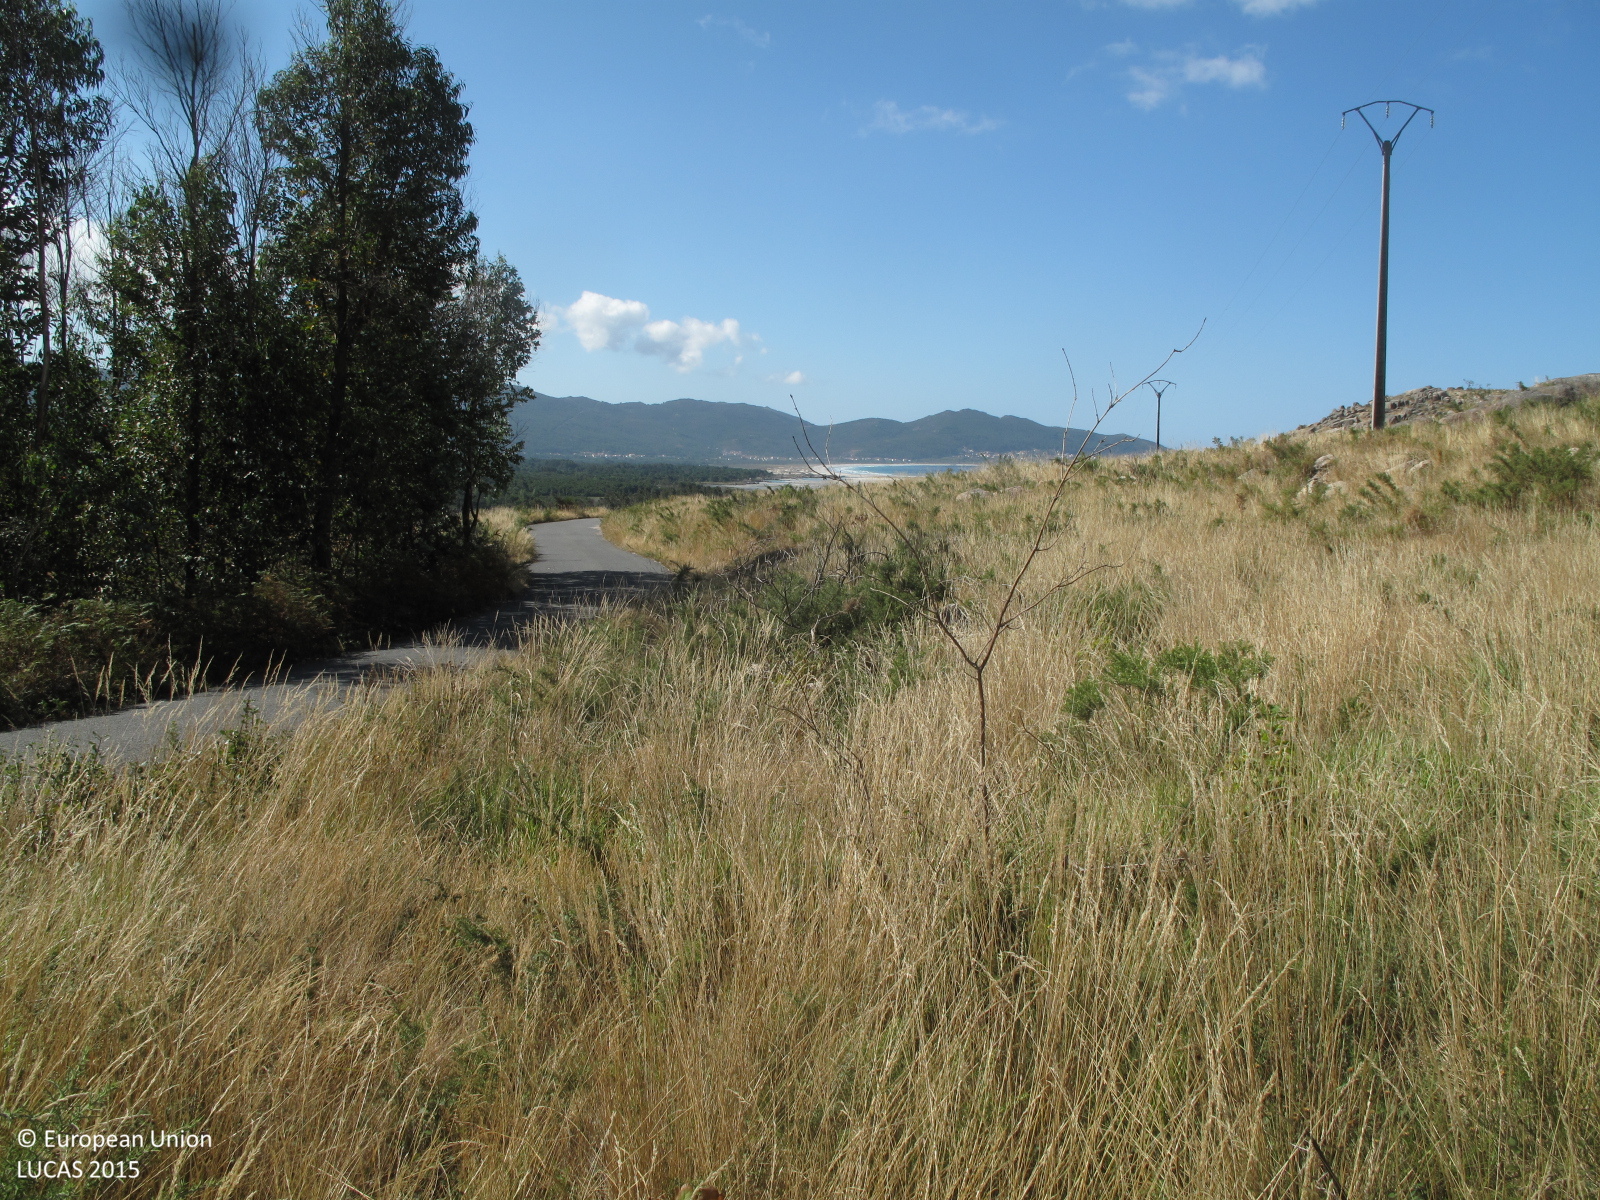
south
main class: Shrubland
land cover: Shrubland with sparse tree cover
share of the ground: 50 - 75 %
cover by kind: shrubs 45 %, herbaceous plants 40 %, unconsolidated bare surface 10 %, coniferous forest trees 5 %
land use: Abandoned areas
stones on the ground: 25 - 50 %
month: July
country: ES
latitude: 42.8687
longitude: -9.1083
